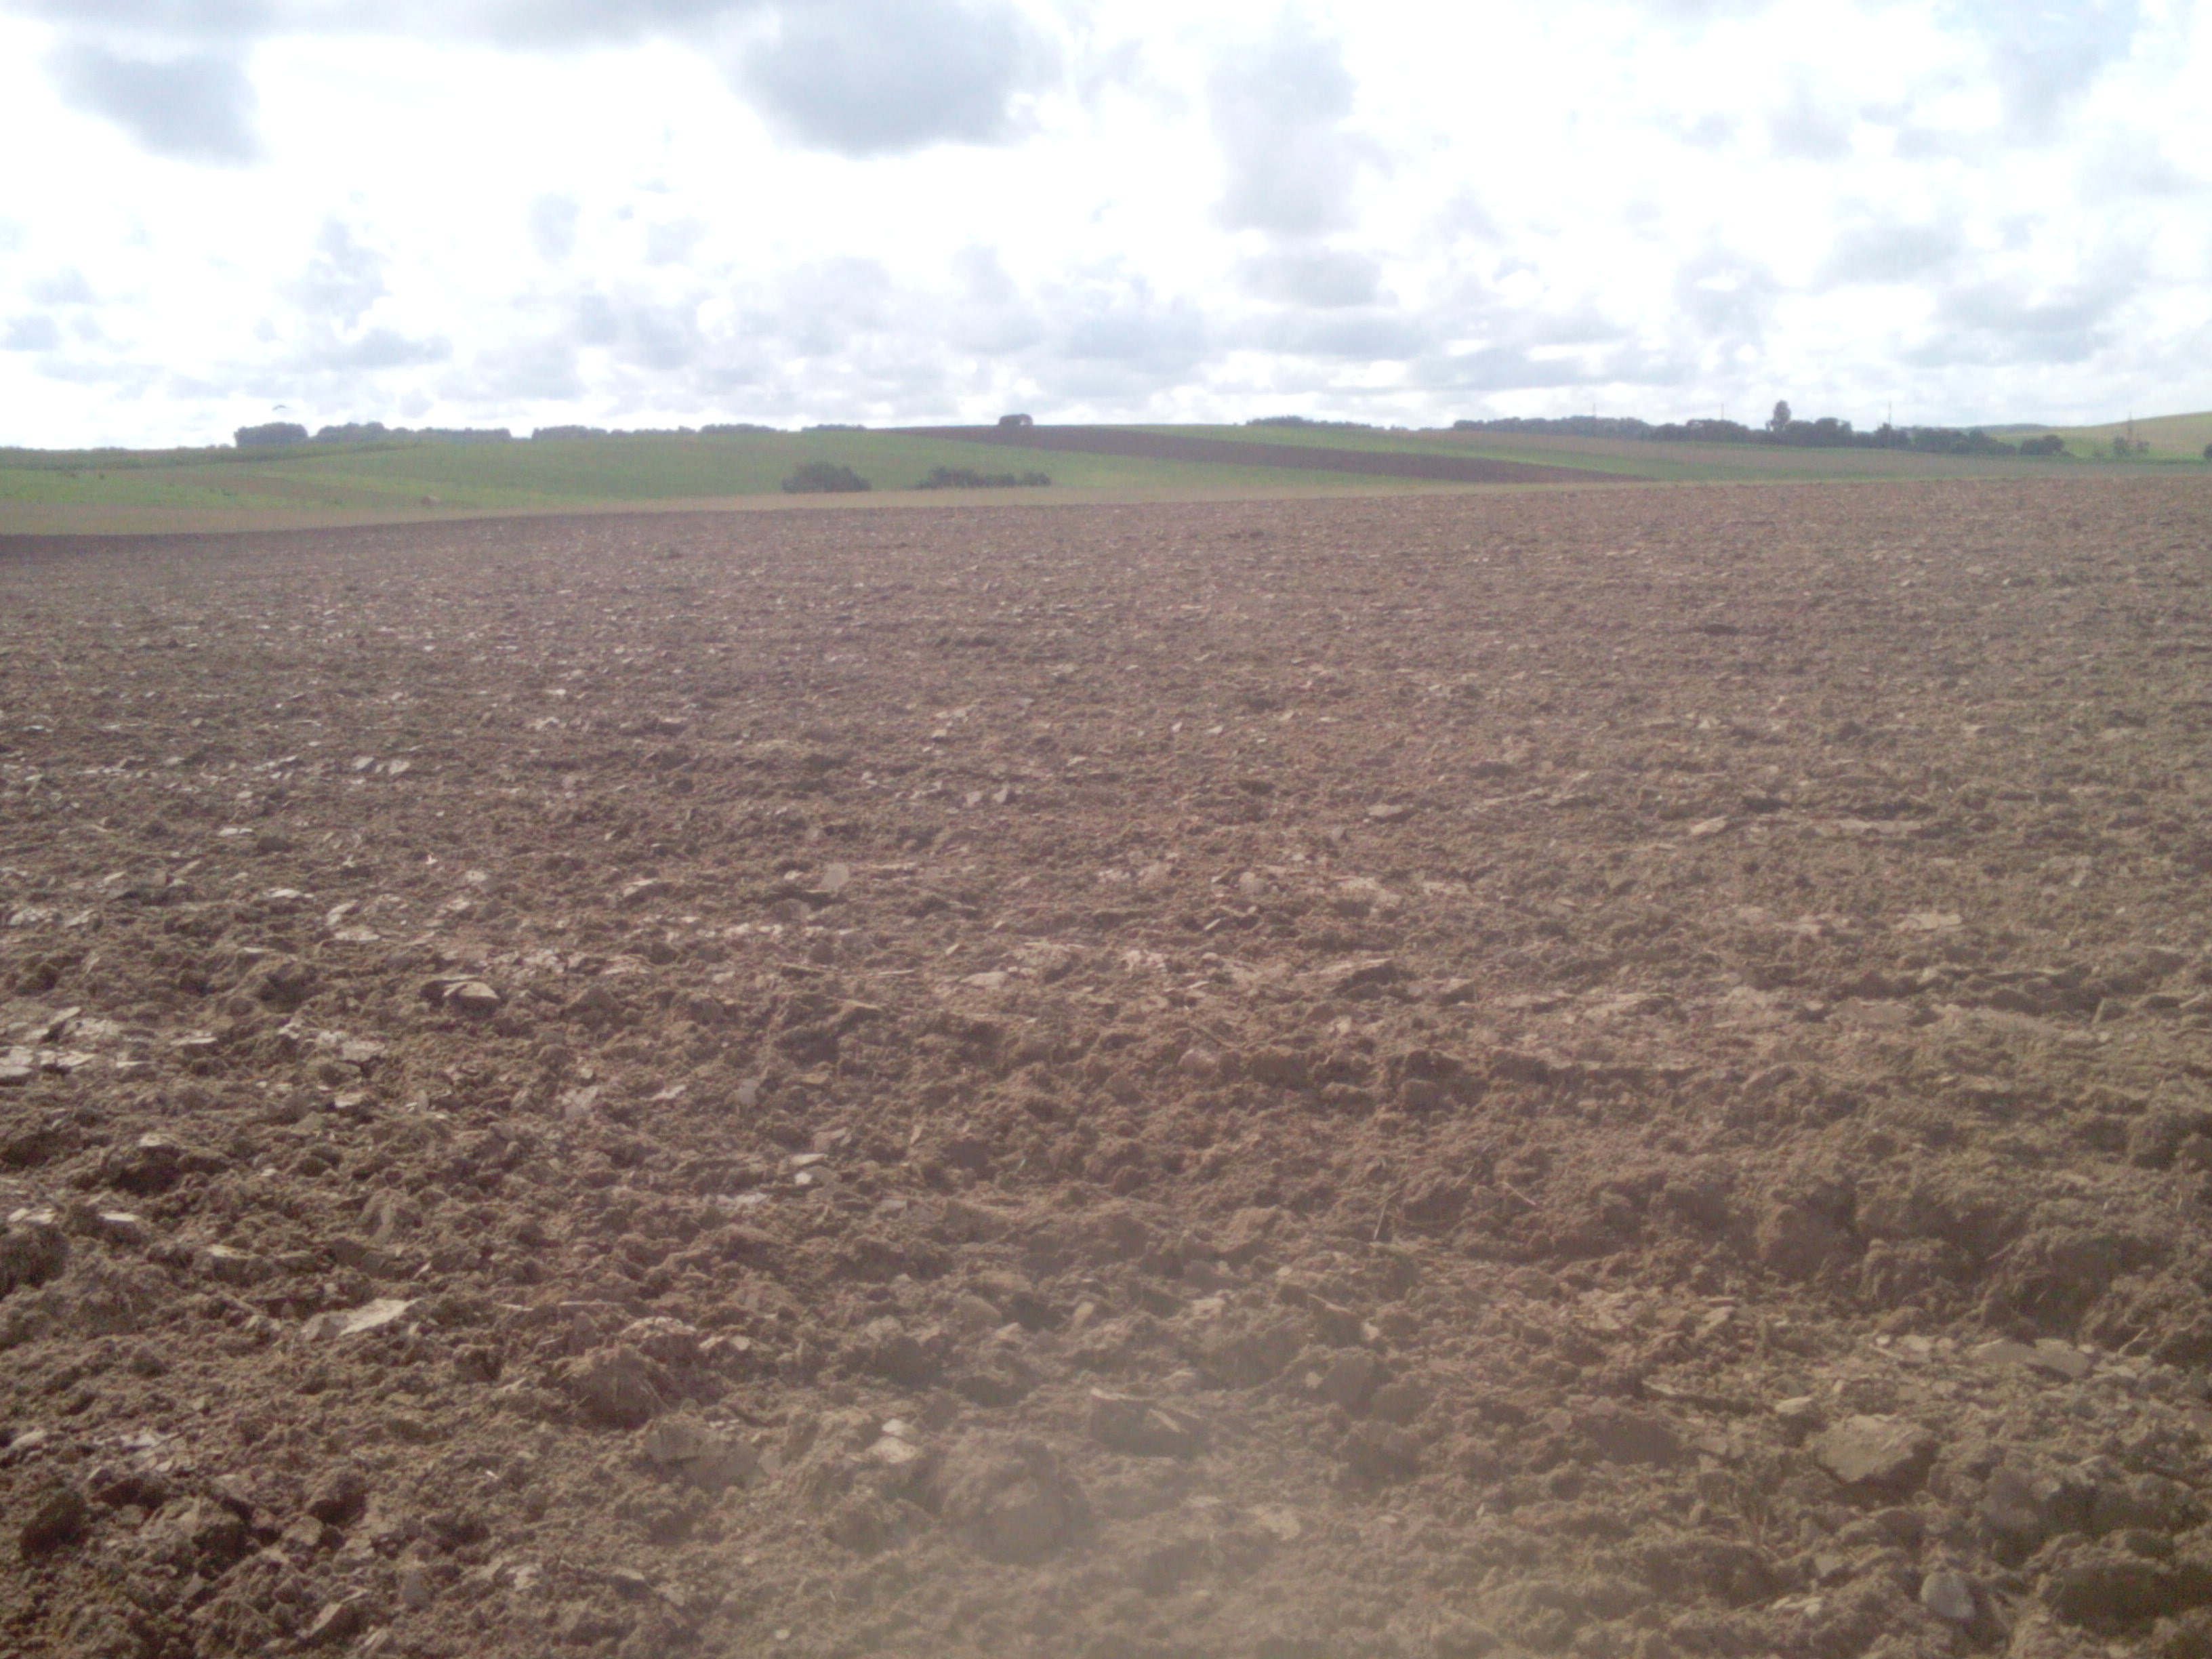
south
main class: Cropland
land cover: Common wheat
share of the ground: < 10 %
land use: Agriculture (excluding fallow land and kitchen gardens)
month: September
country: LT
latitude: 55.9027
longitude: 22.4871
